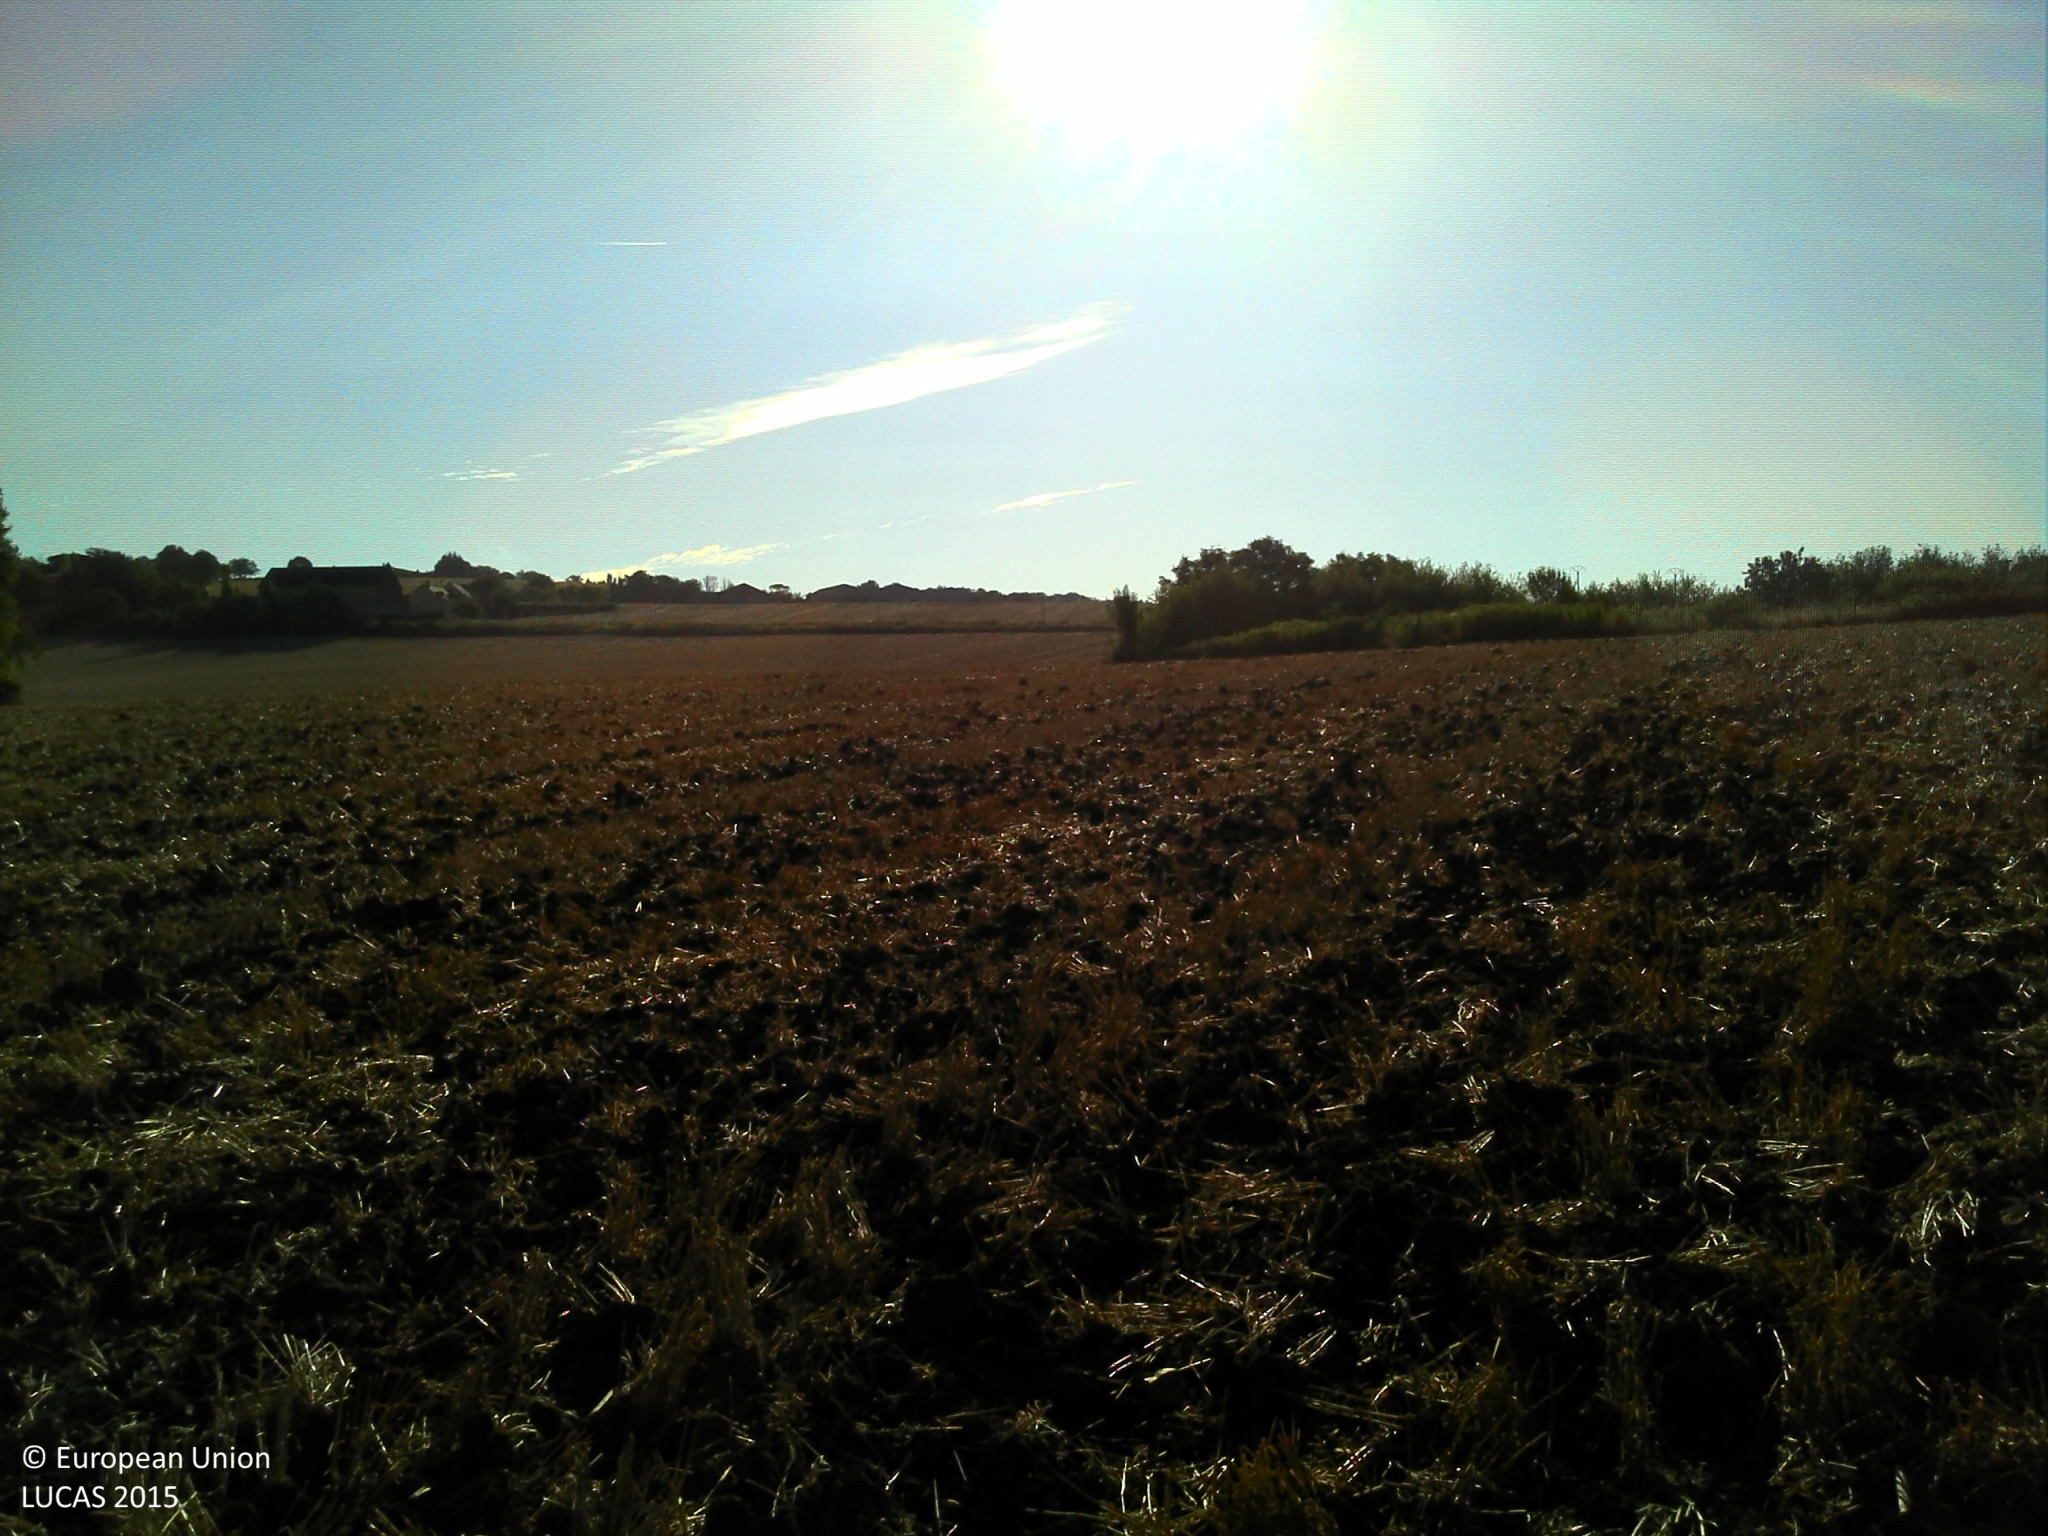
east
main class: Cropland
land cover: Common wheat
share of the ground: 25 - 50 %
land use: Agriculture (excluding fallow land and kitchen gardens)
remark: Tilled/Sowed
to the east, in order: Common wheat; Fences; Managed hedges; Fences; Common wheat
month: August
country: FR
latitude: 46.8387
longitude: 0.5542
